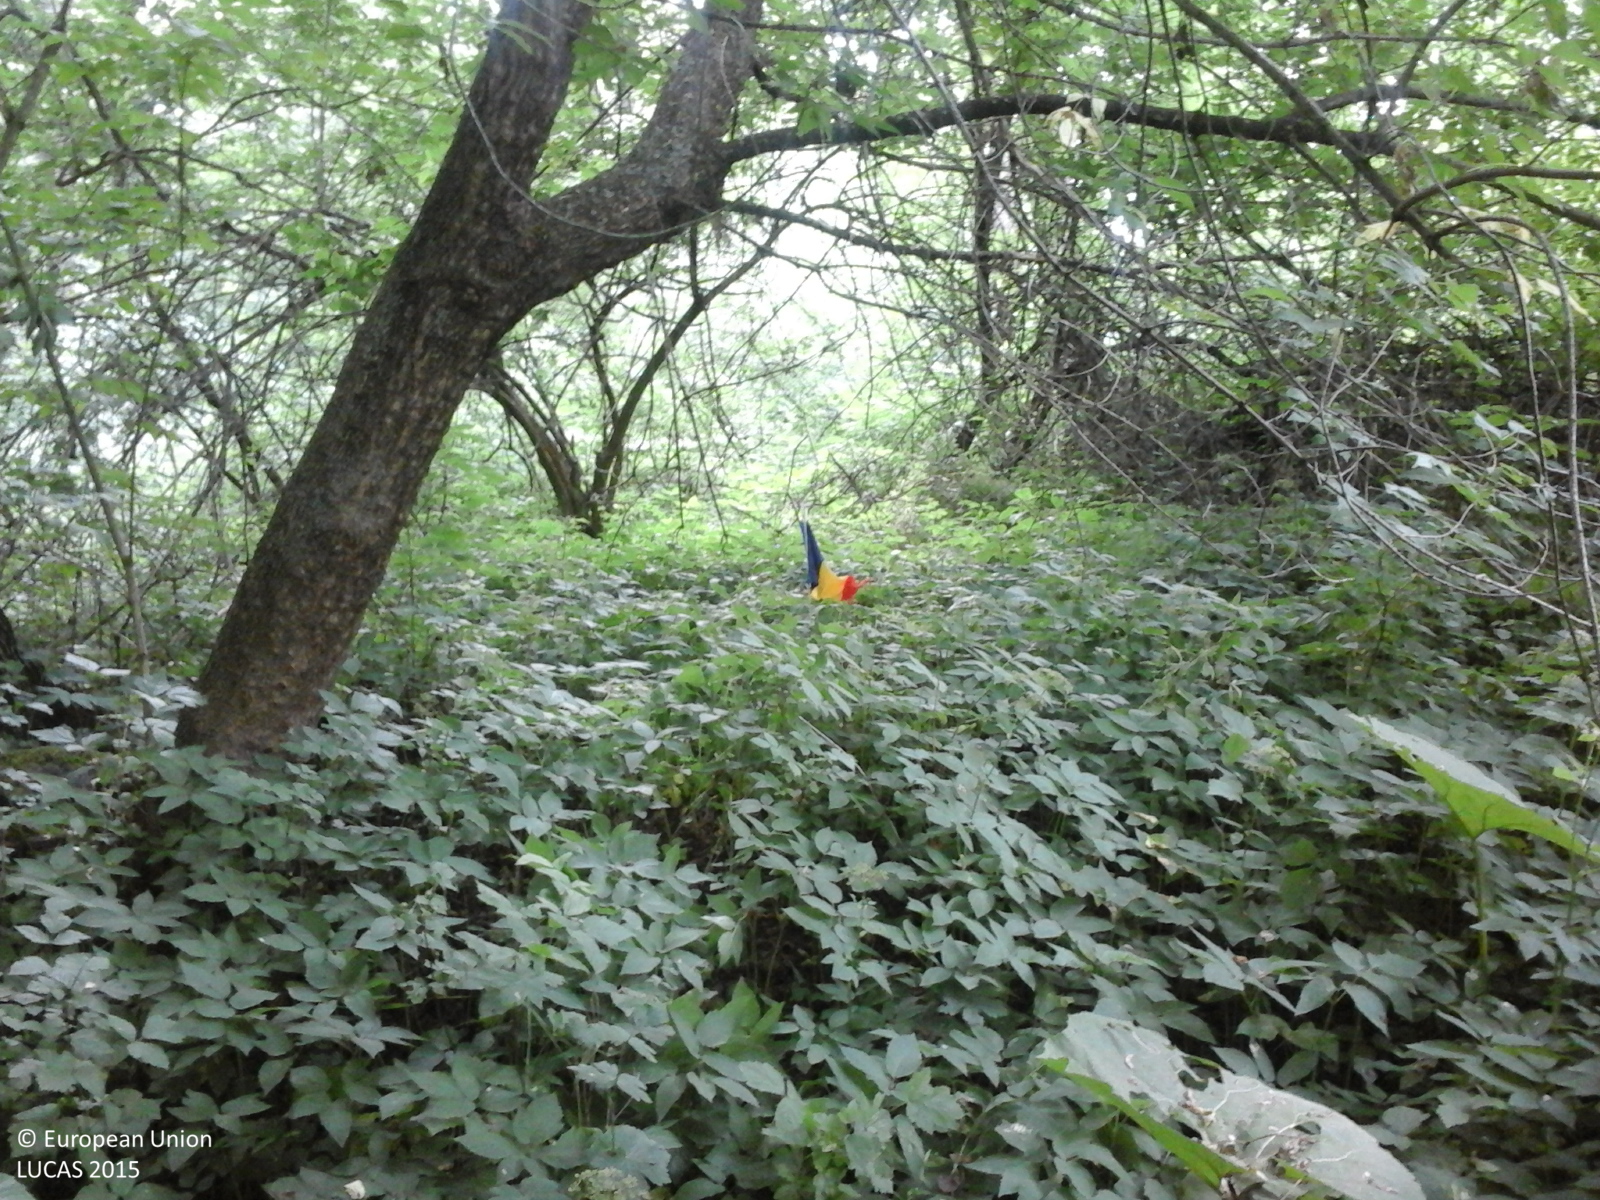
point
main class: Woodland
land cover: Broadleaved woodland
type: non-riverine alder, birch or aspen forest
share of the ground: > 75 %
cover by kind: broadleaved forest trees 100 %
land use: Forestry
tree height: > 5 m
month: June
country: RO
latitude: 47.4806
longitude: 26.3952
